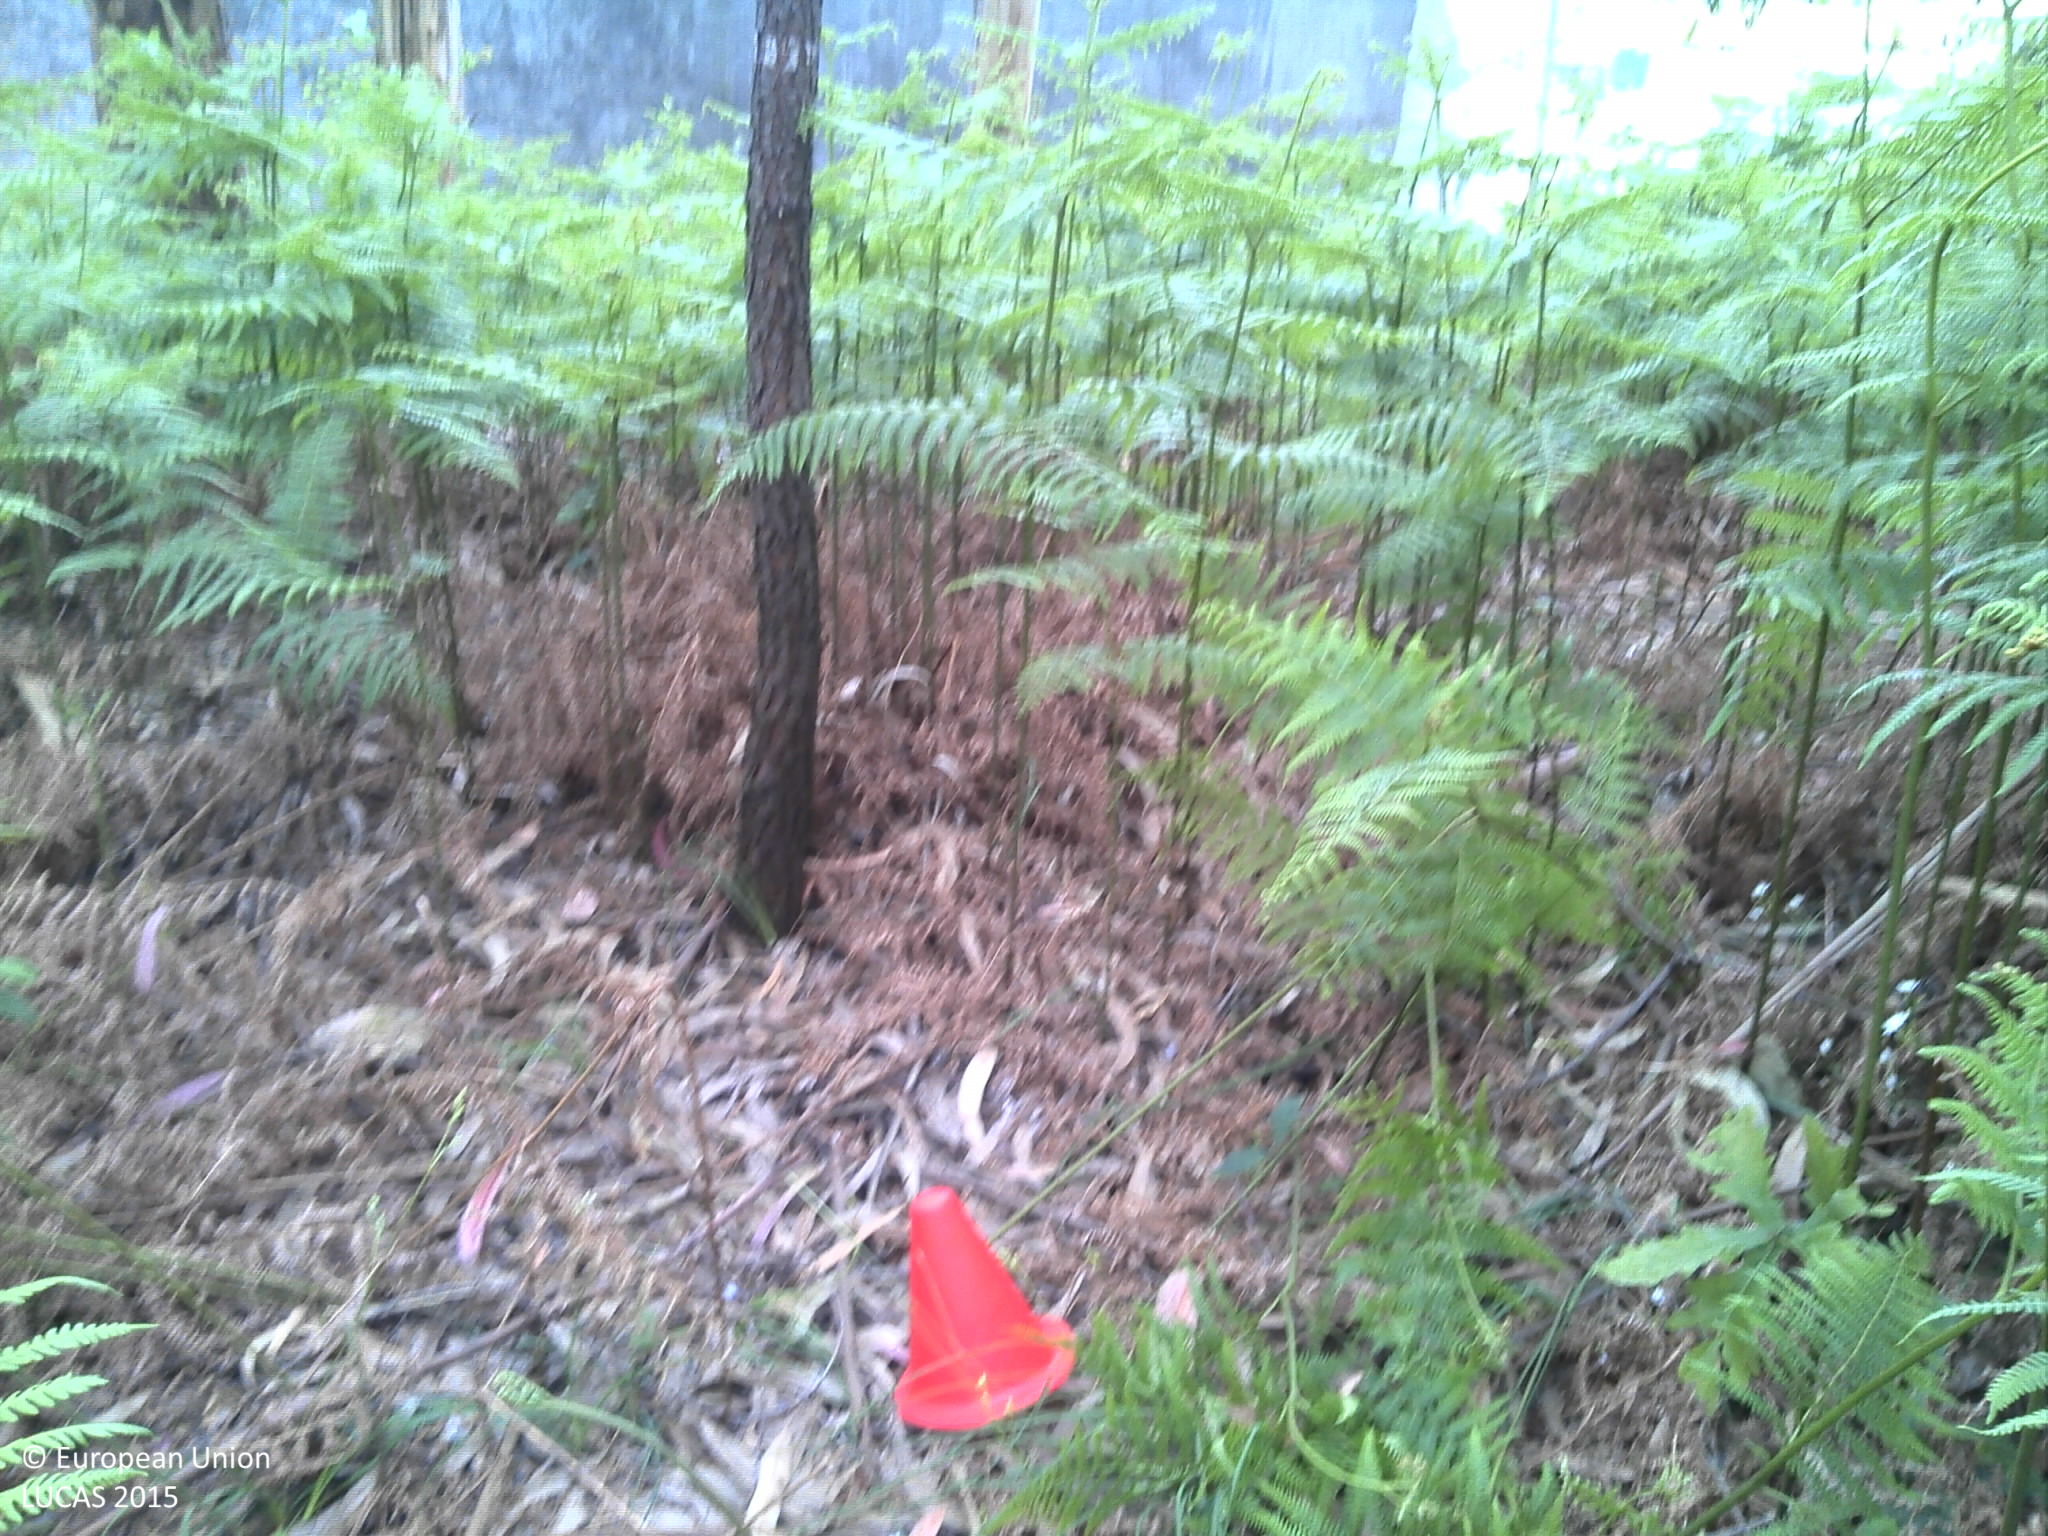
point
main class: Woodland
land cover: Broadleaved woodland
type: exotic forest
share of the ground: > 75 %
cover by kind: broadleaved forest trees 80 %, shrubs 10 %, herbaceous plants 5 %, unconsolidated bare surface 5 %
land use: Forestry
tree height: > 5 m
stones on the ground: < 10 %
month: May
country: PT
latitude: 40.9069
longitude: -8.4378
